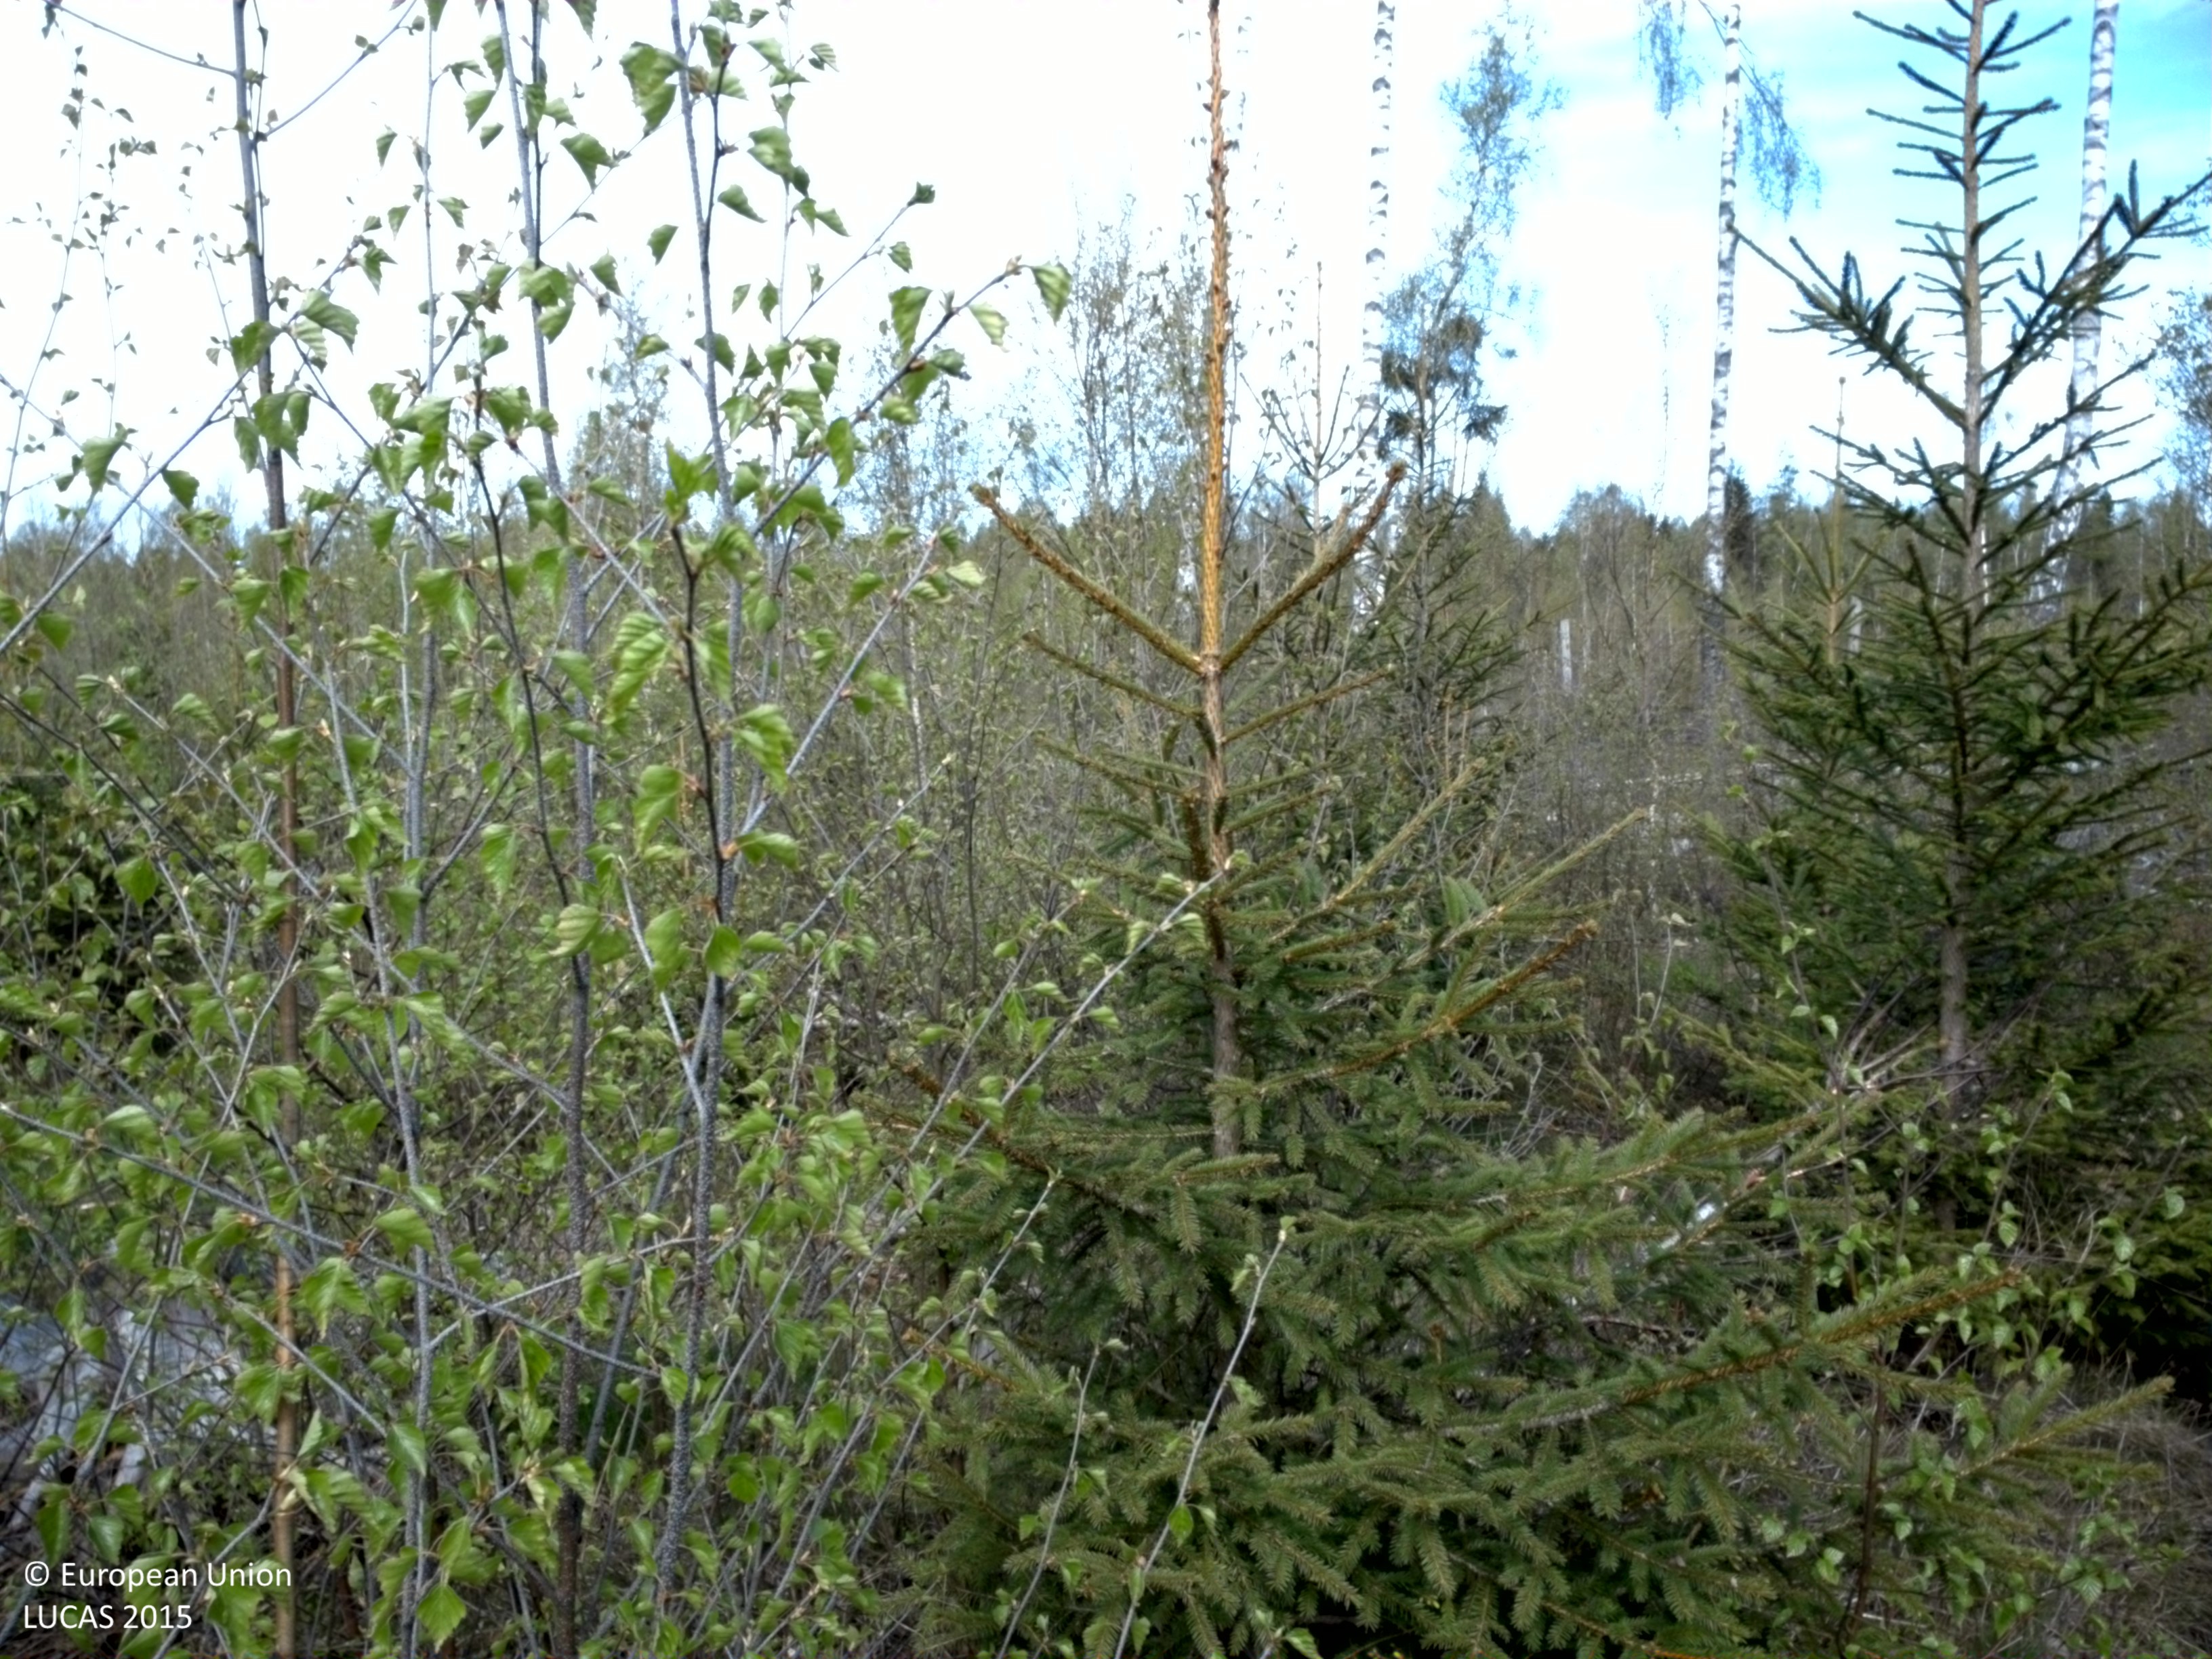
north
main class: Woodland
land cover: Spruce dominated mixed woodland
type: boreal forest
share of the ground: 50 - 75 %
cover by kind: broadleaved forest trees 40 %, coniferous forest trees 30 %, herbaceous plants 15 %, lichens and mosses 15 %
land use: Forestry
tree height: > 5 m
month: May
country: SE
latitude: 56.6931
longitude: 14.7817
